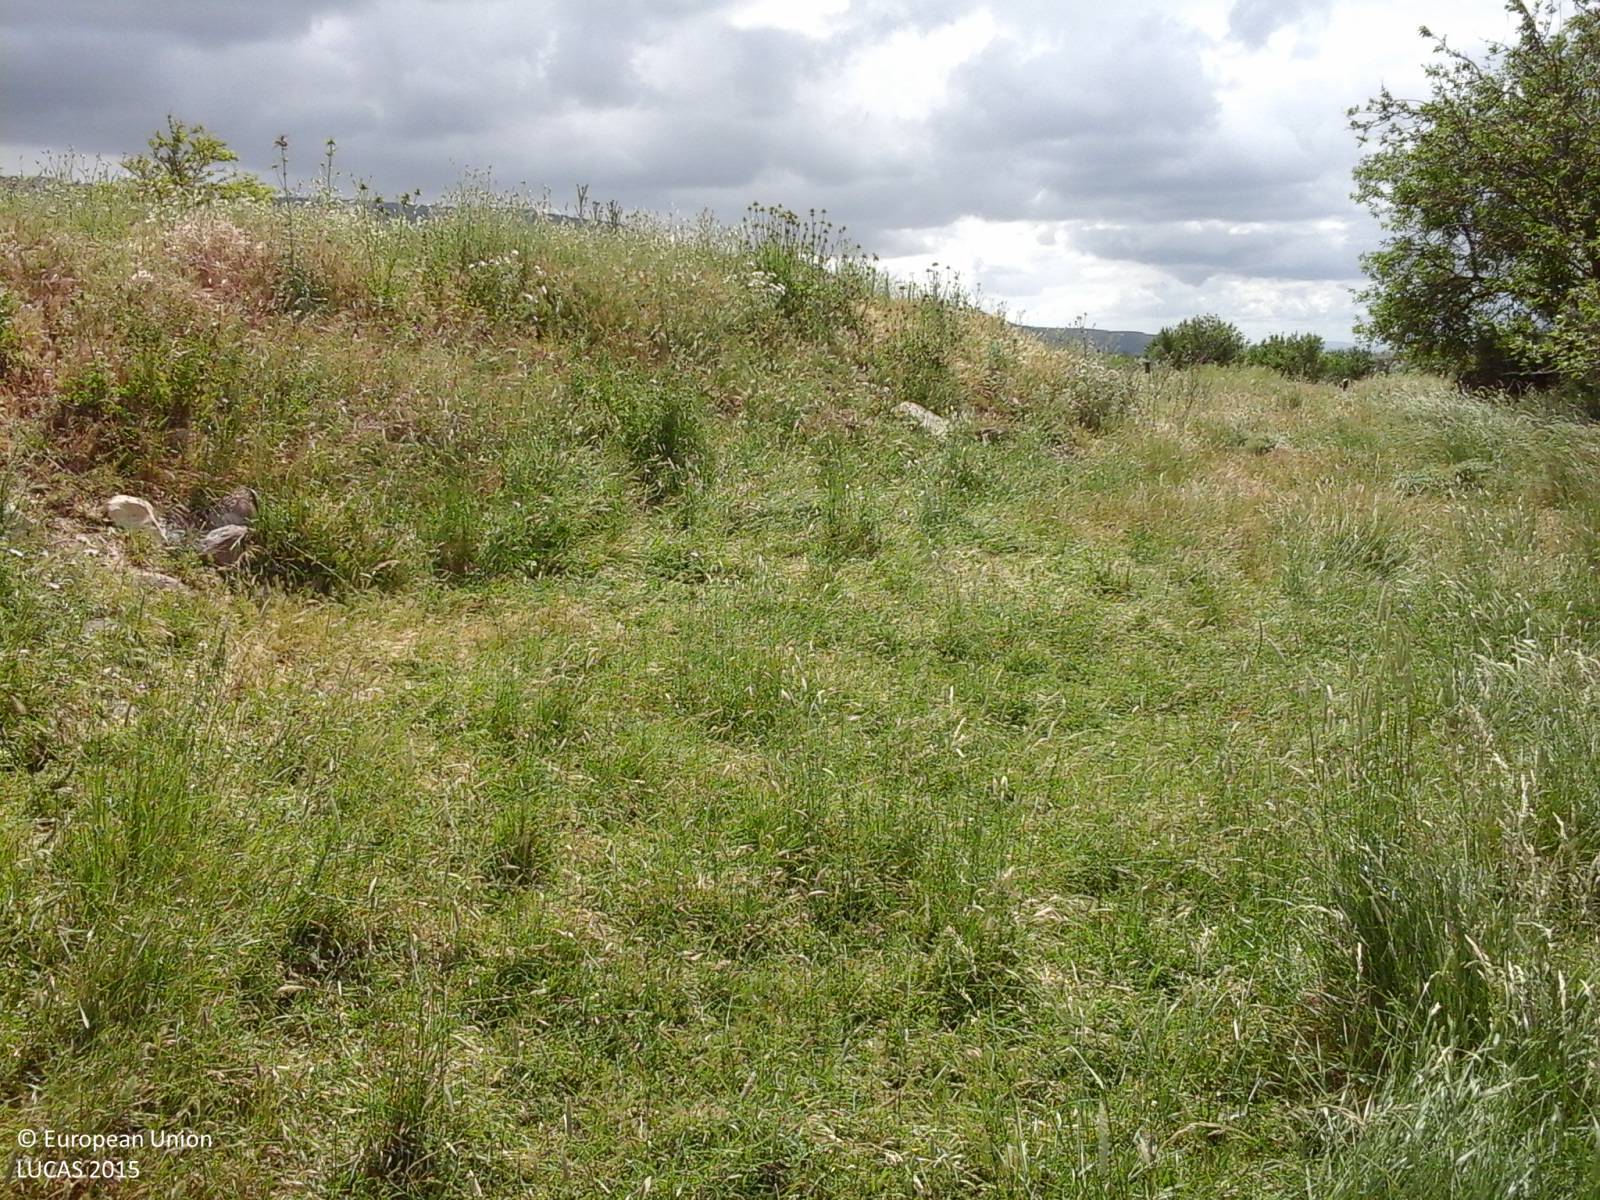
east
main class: Grassland
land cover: Spontaneously vegetated surfaces
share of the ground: > 75 %
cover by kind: herbaceous plants 95 %, shrubs 5 %
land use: Agriculture (excluding fallow land and kitchen gardens)
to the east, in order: Spontaneously vegetated surfaces; Ditches and canals; Paved roads, cycling and walking lanes; Grass margins; Grassland without tree/shrub cover; Single bushes/trees; Grassland without tree/shrub cover; Fences; Grassland without tree/shrub cover; Fences; Grassland without tree/shrub cover; Artificial constructions in urban areas; Grassland without tree/shrub cover; Lines of trees; Artificial constructions in urban areas
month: May
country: IT
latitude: 39.7541
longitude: 8.8975
